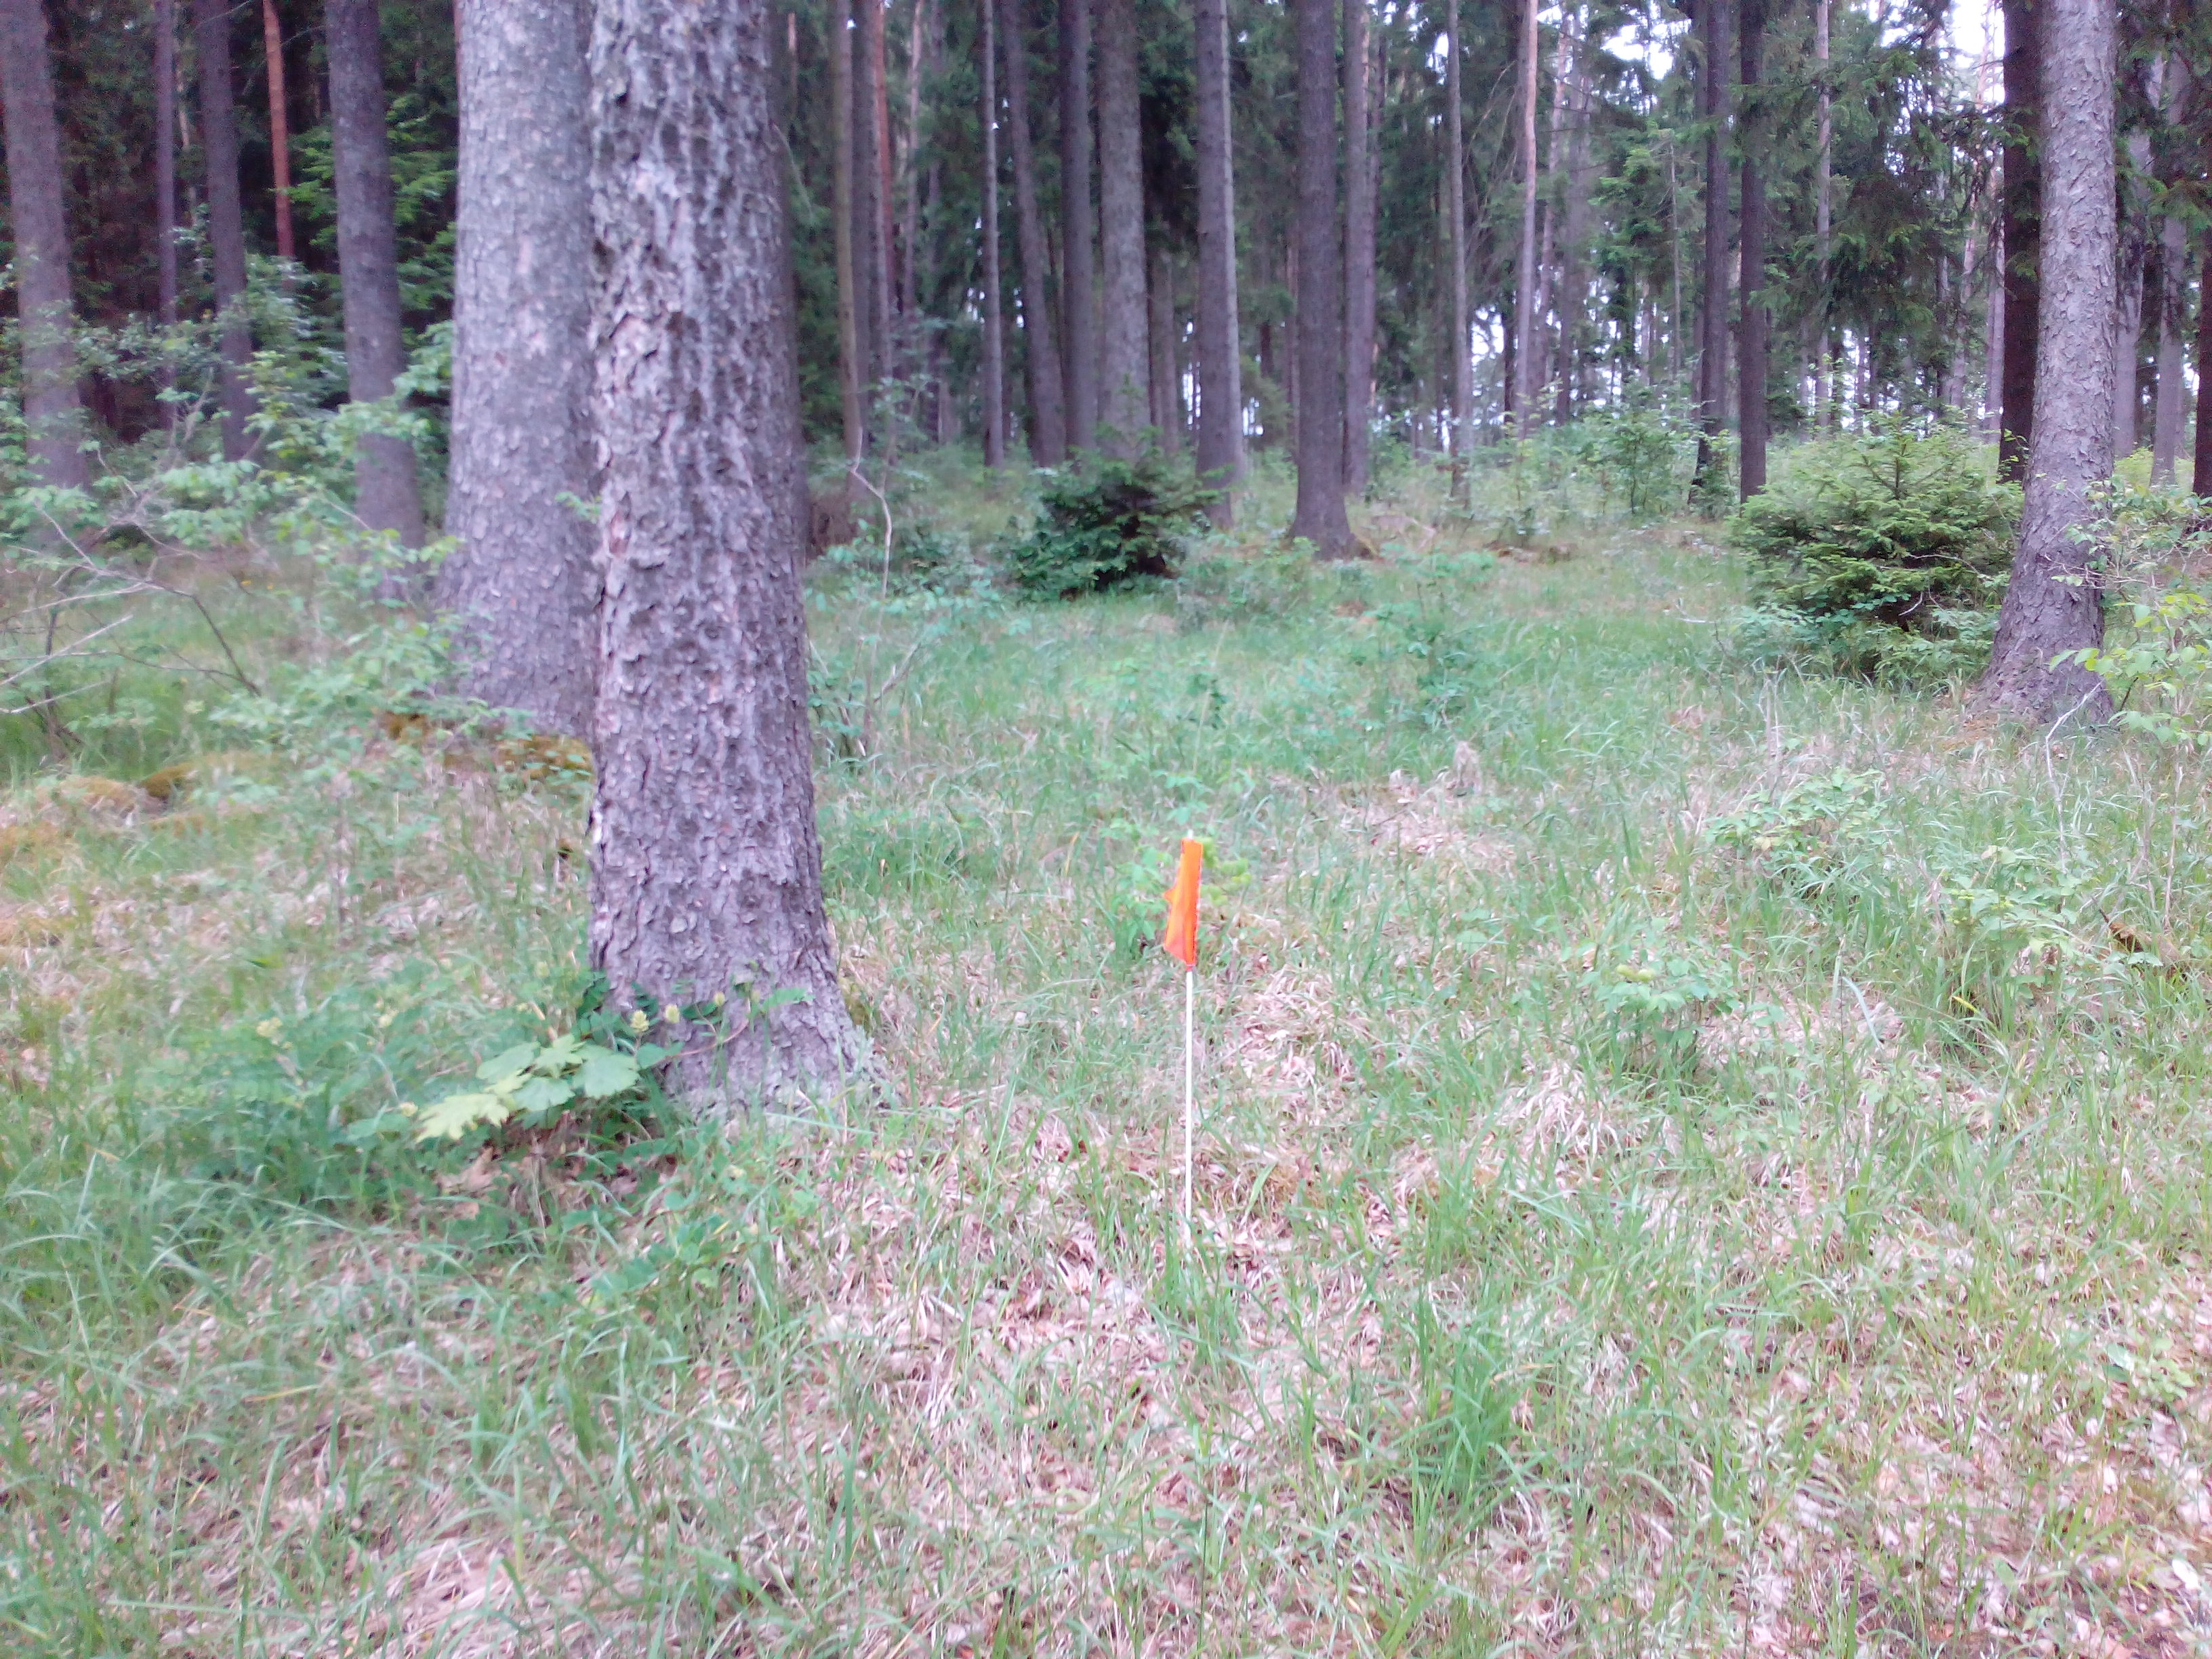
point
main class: Woodland
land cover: Spruce dominated coniferous woodland
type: hemiboreal forest and nemoral coniferous forest and mixed broadleaved-coniferous forest
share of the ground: 50 - 75 %
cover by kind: coniferous forest trees 60 %, herbaceous plants 30 %, shrubs 10 %
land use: Forestry
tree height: > 5 m
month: June
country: DE
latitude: 50.4522
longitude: 10.6336
